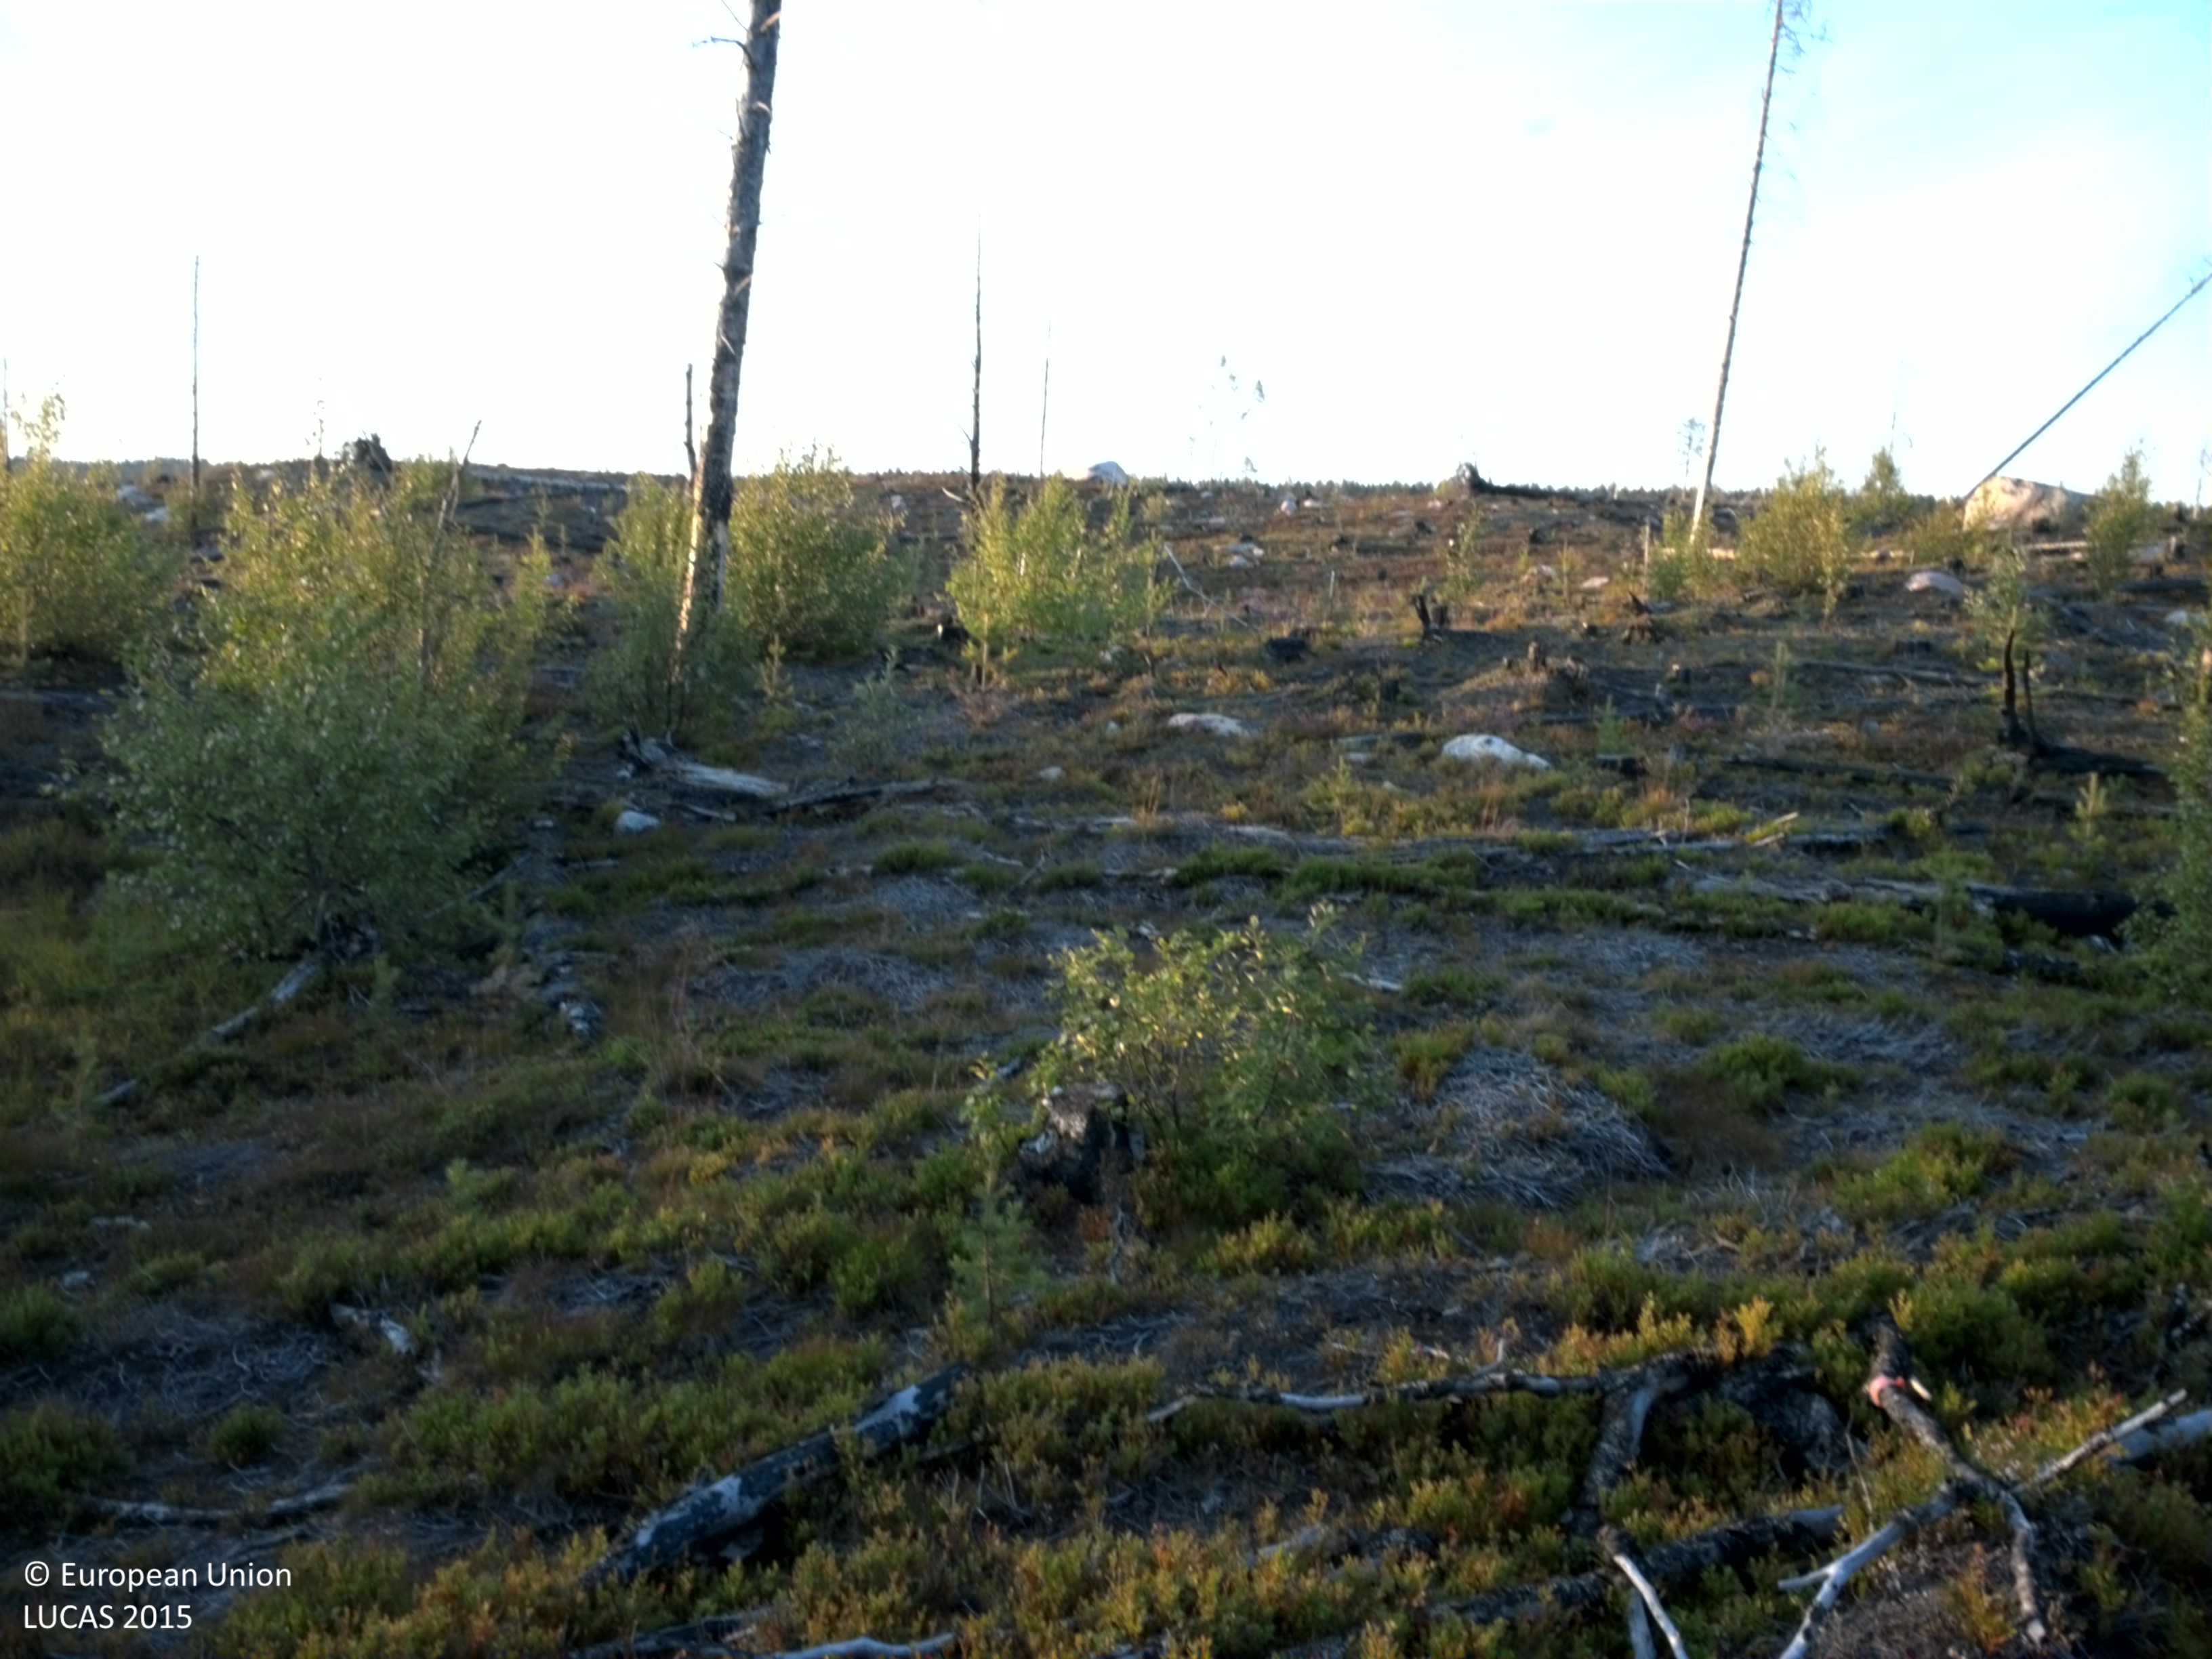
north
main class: Woodland
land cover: Broadleaved woodland
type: boreal forest
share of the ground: 10 - 25 %
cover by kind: shrubs 65 %, broadleaved forest trees 15 %, lichens and mosses 15 %
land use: Forestry
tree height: < 5 m
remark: Clear cut
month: August
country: SE
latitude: 66.6326
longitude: 19.1010
